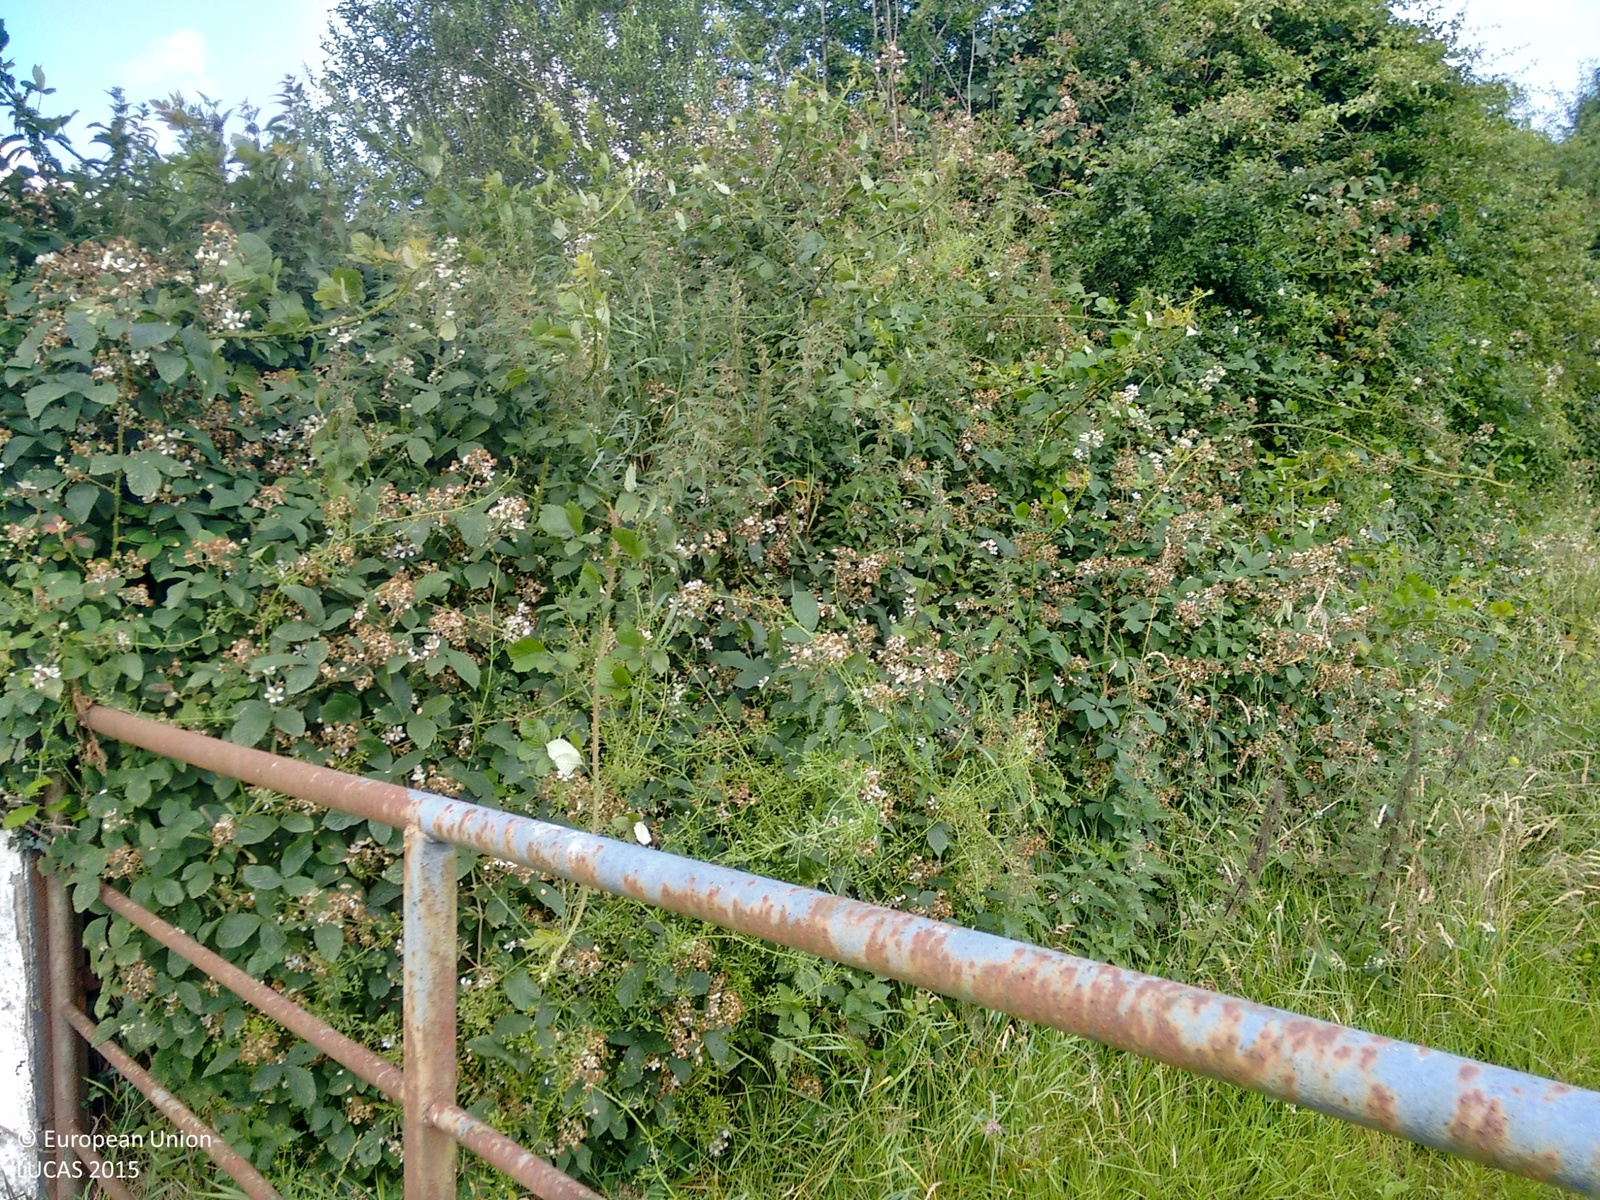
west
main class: Cropland
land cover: Barley
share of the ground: > 75 %
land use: Agriculture (excluding fallow land and kitchen gardens)
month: July
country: IE
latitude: 52.2203
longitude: -8.9323
